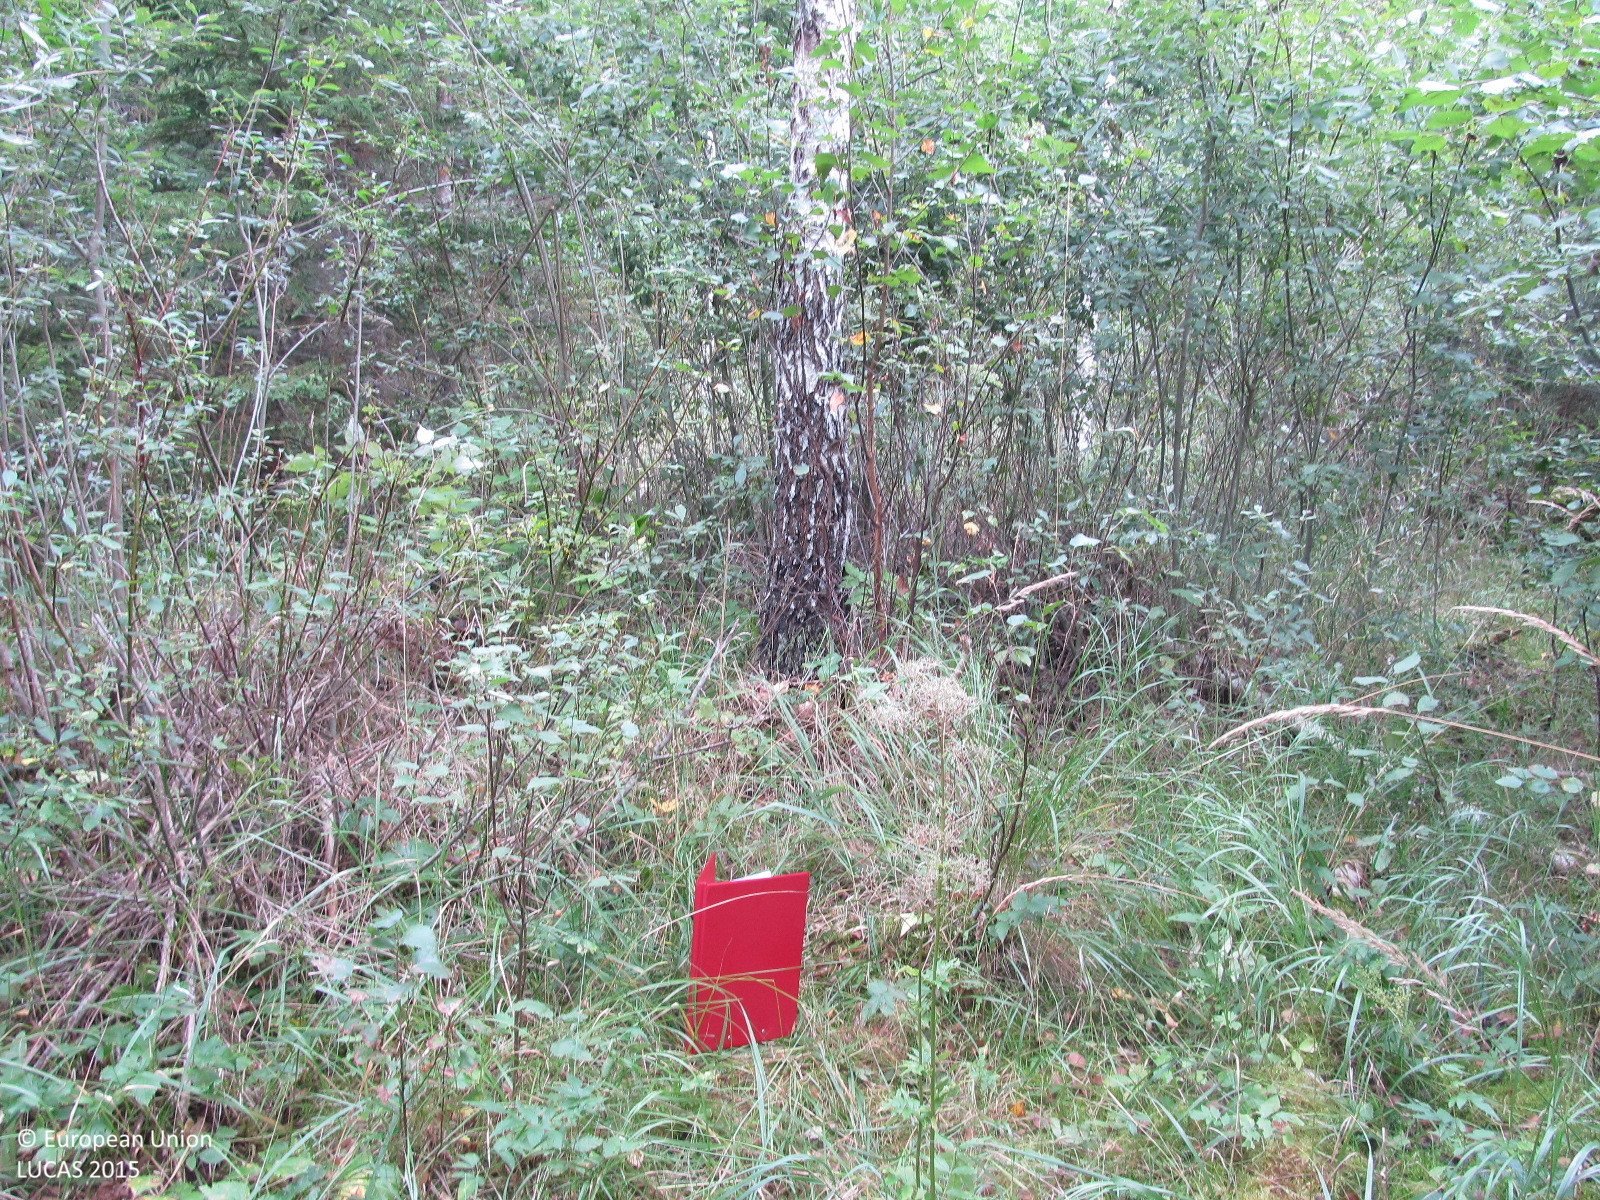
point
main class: Woodland
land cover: Spruce dominated mixed woodland
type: hemiboreal forest and nemoral coniferous forest and mixed broadleaved-coniferous forest
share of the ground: > 75 %
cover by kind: coniferous forest trees 50 %, broadleaved forest trees 30 %, shrubs 10 %, herbaceous plants 5 %, lichens and mosses 5 %
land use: Forestry
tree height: > 5 m
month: September
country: LT
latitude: 56.2862
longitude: 23.2040
